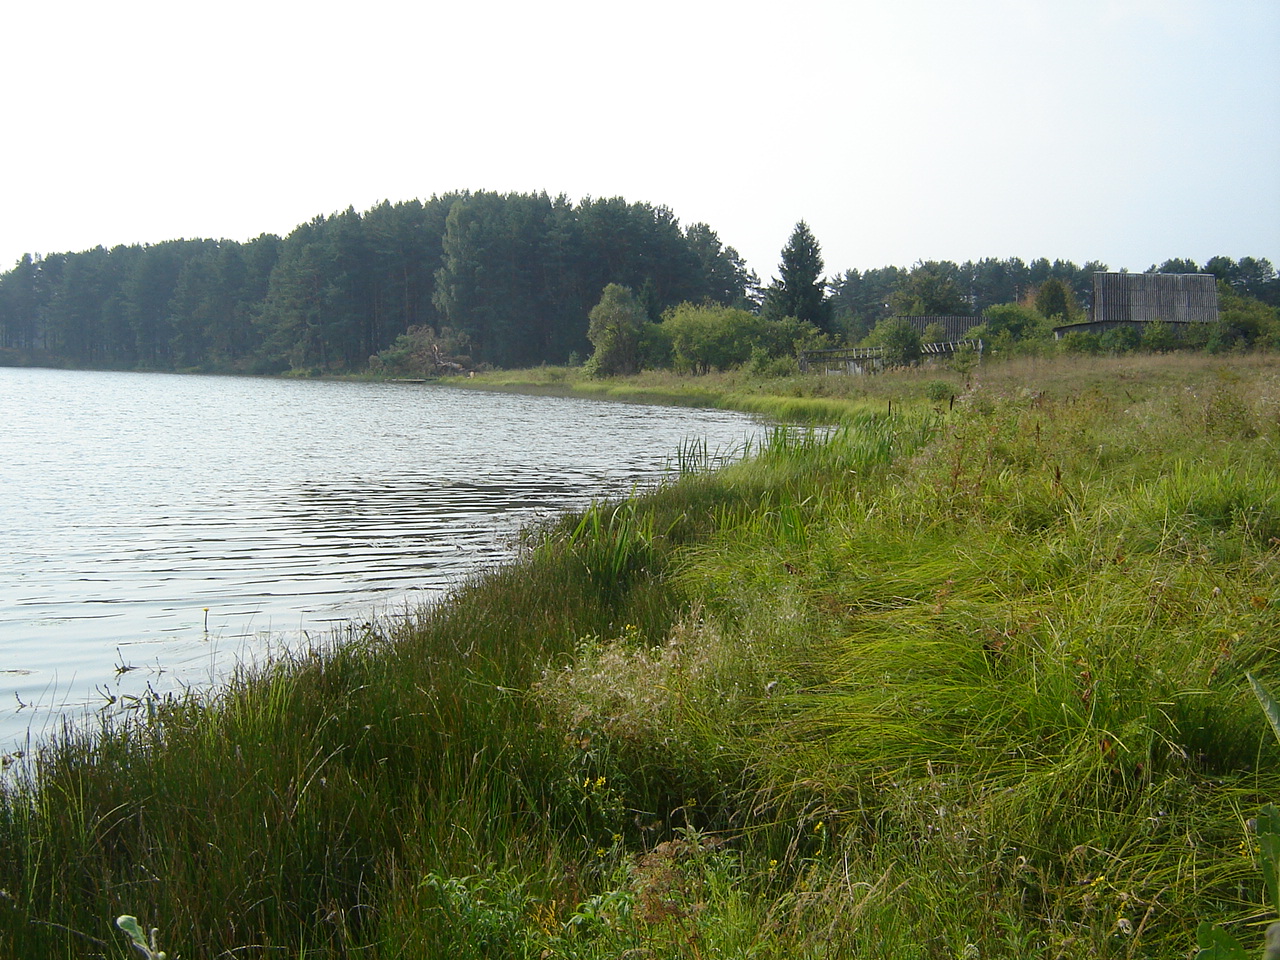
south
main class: Grassland
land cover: Spontaneously vegetated surfaces
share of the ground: > 75 %
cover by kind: herbaceous plants 100 %
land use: Semi-natural and natural areas not in use
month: September
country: LT
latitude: 54.5462
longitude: 25.1601
